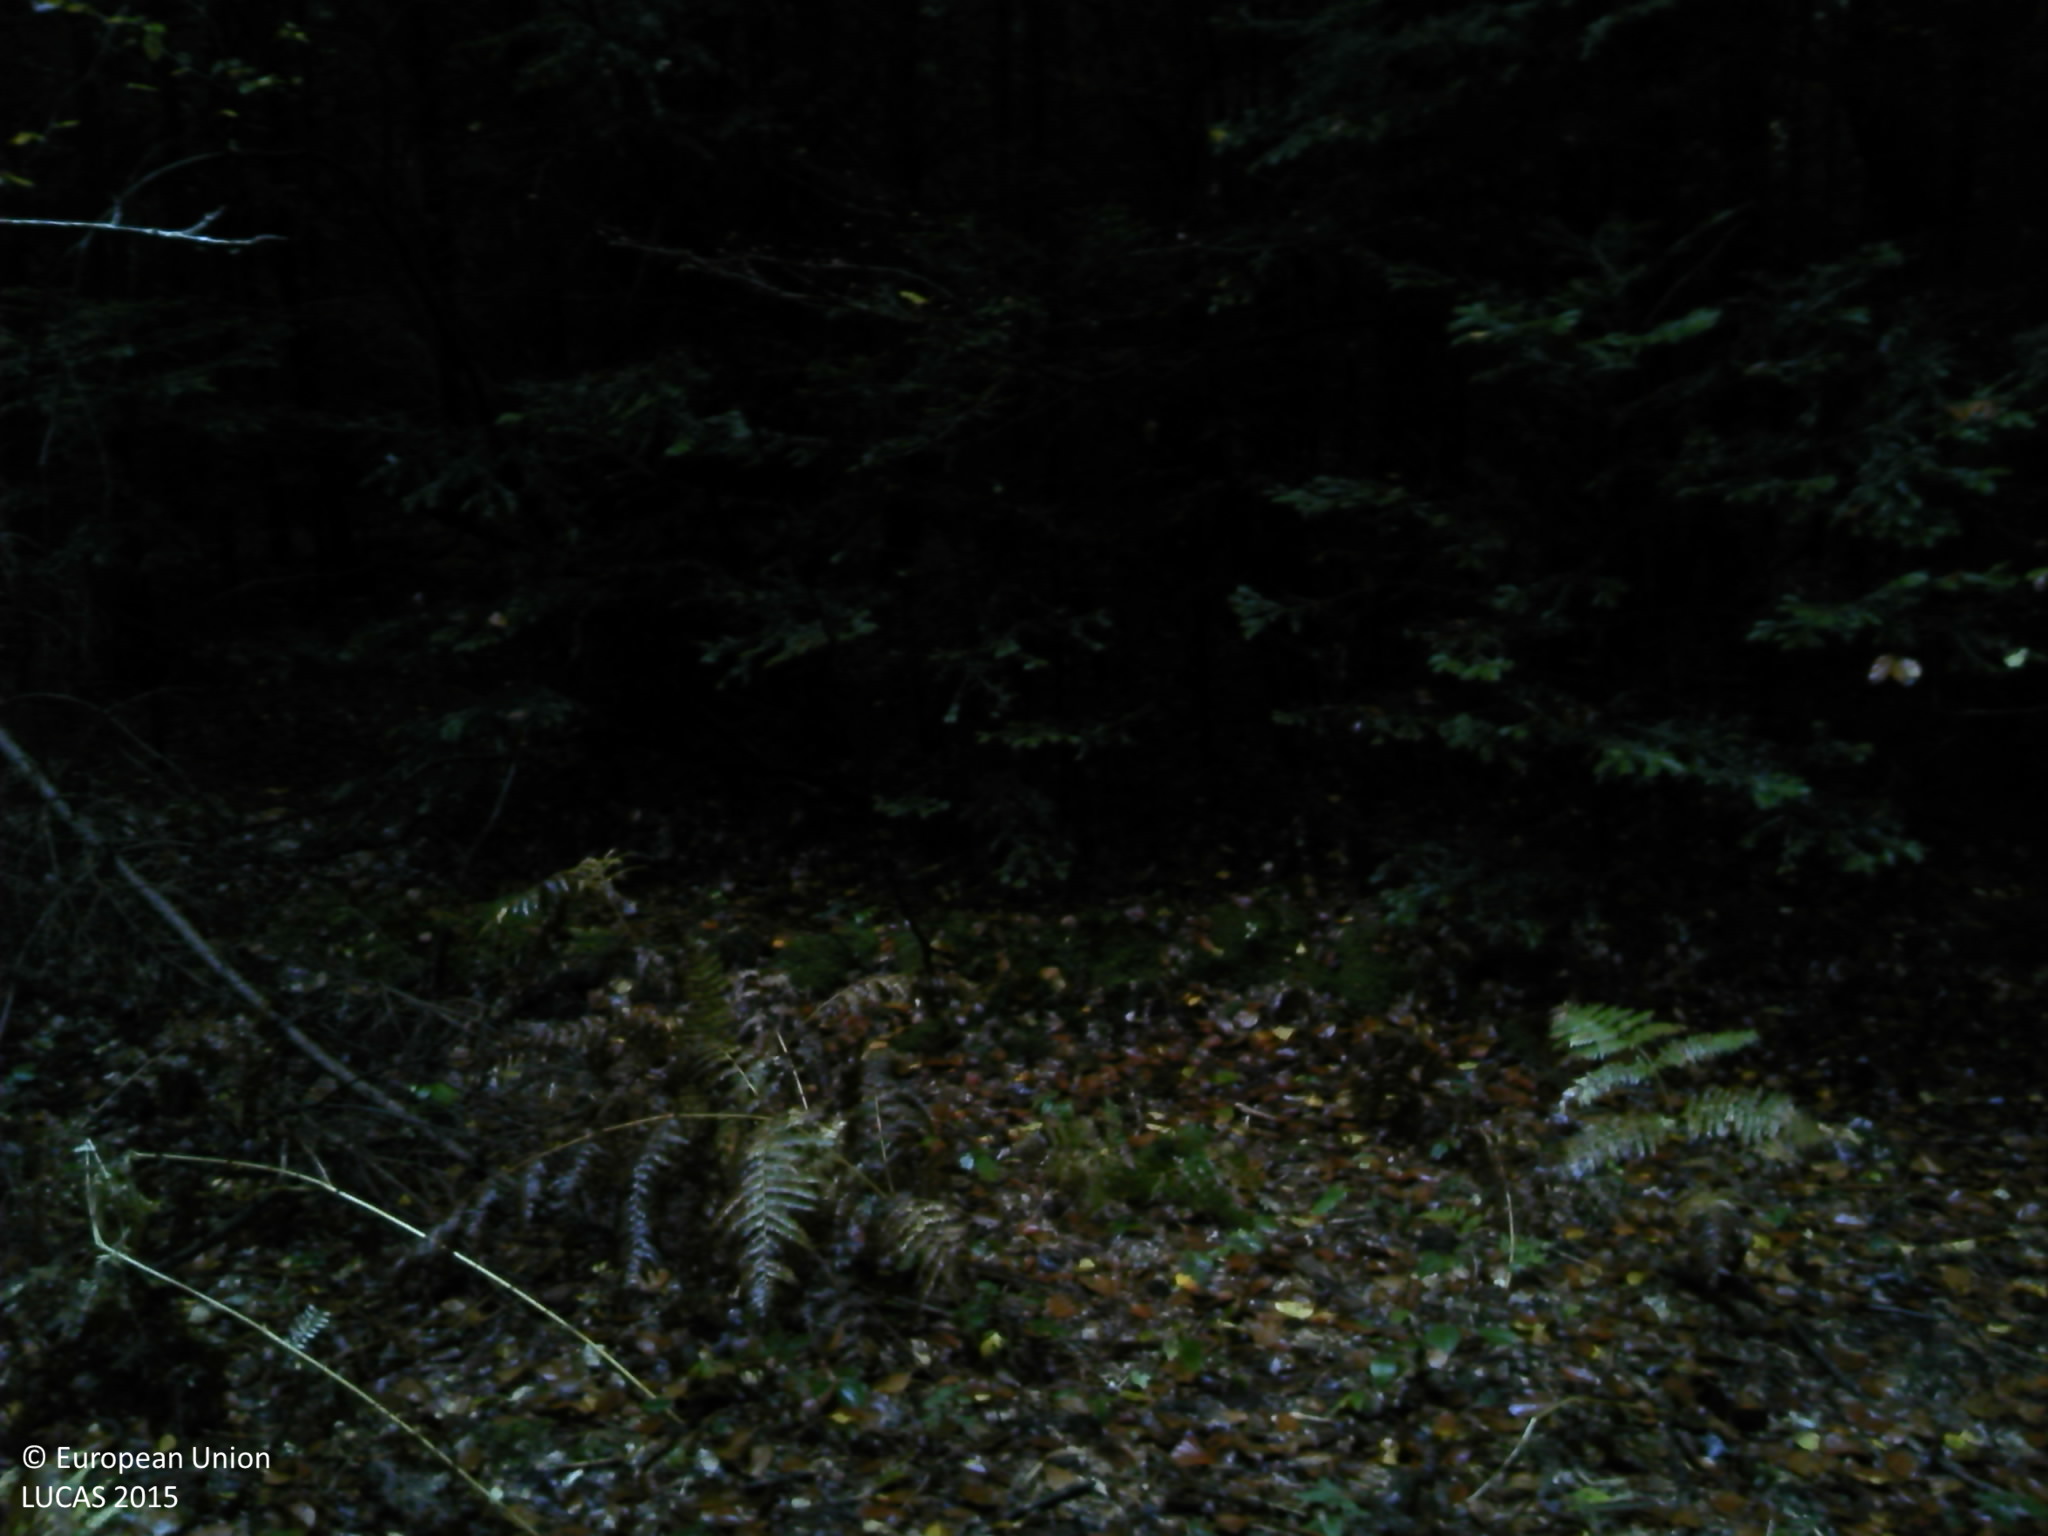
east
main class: Woodland
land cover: Spruce dominated coniferous woodland
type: alpine coniferous forest
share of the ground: > 75 %
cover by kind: coniferous forest trees 85 %, broadleaved forest trees 15 %
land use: Forestry
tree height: > 5 m
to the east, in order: Spruce dominated coniferous woodland; Ditches and canals; Spruce dominated coniferous woodland; Rivers and streams; Spruce dominated coniferous woodland; Ditches and canals; Spruce dominated coniferous woodland; Spruce dominated mixed woodland; Grassland without tree/shrub cover
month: October
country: FR
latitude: 46.9782
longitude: 4.0177
